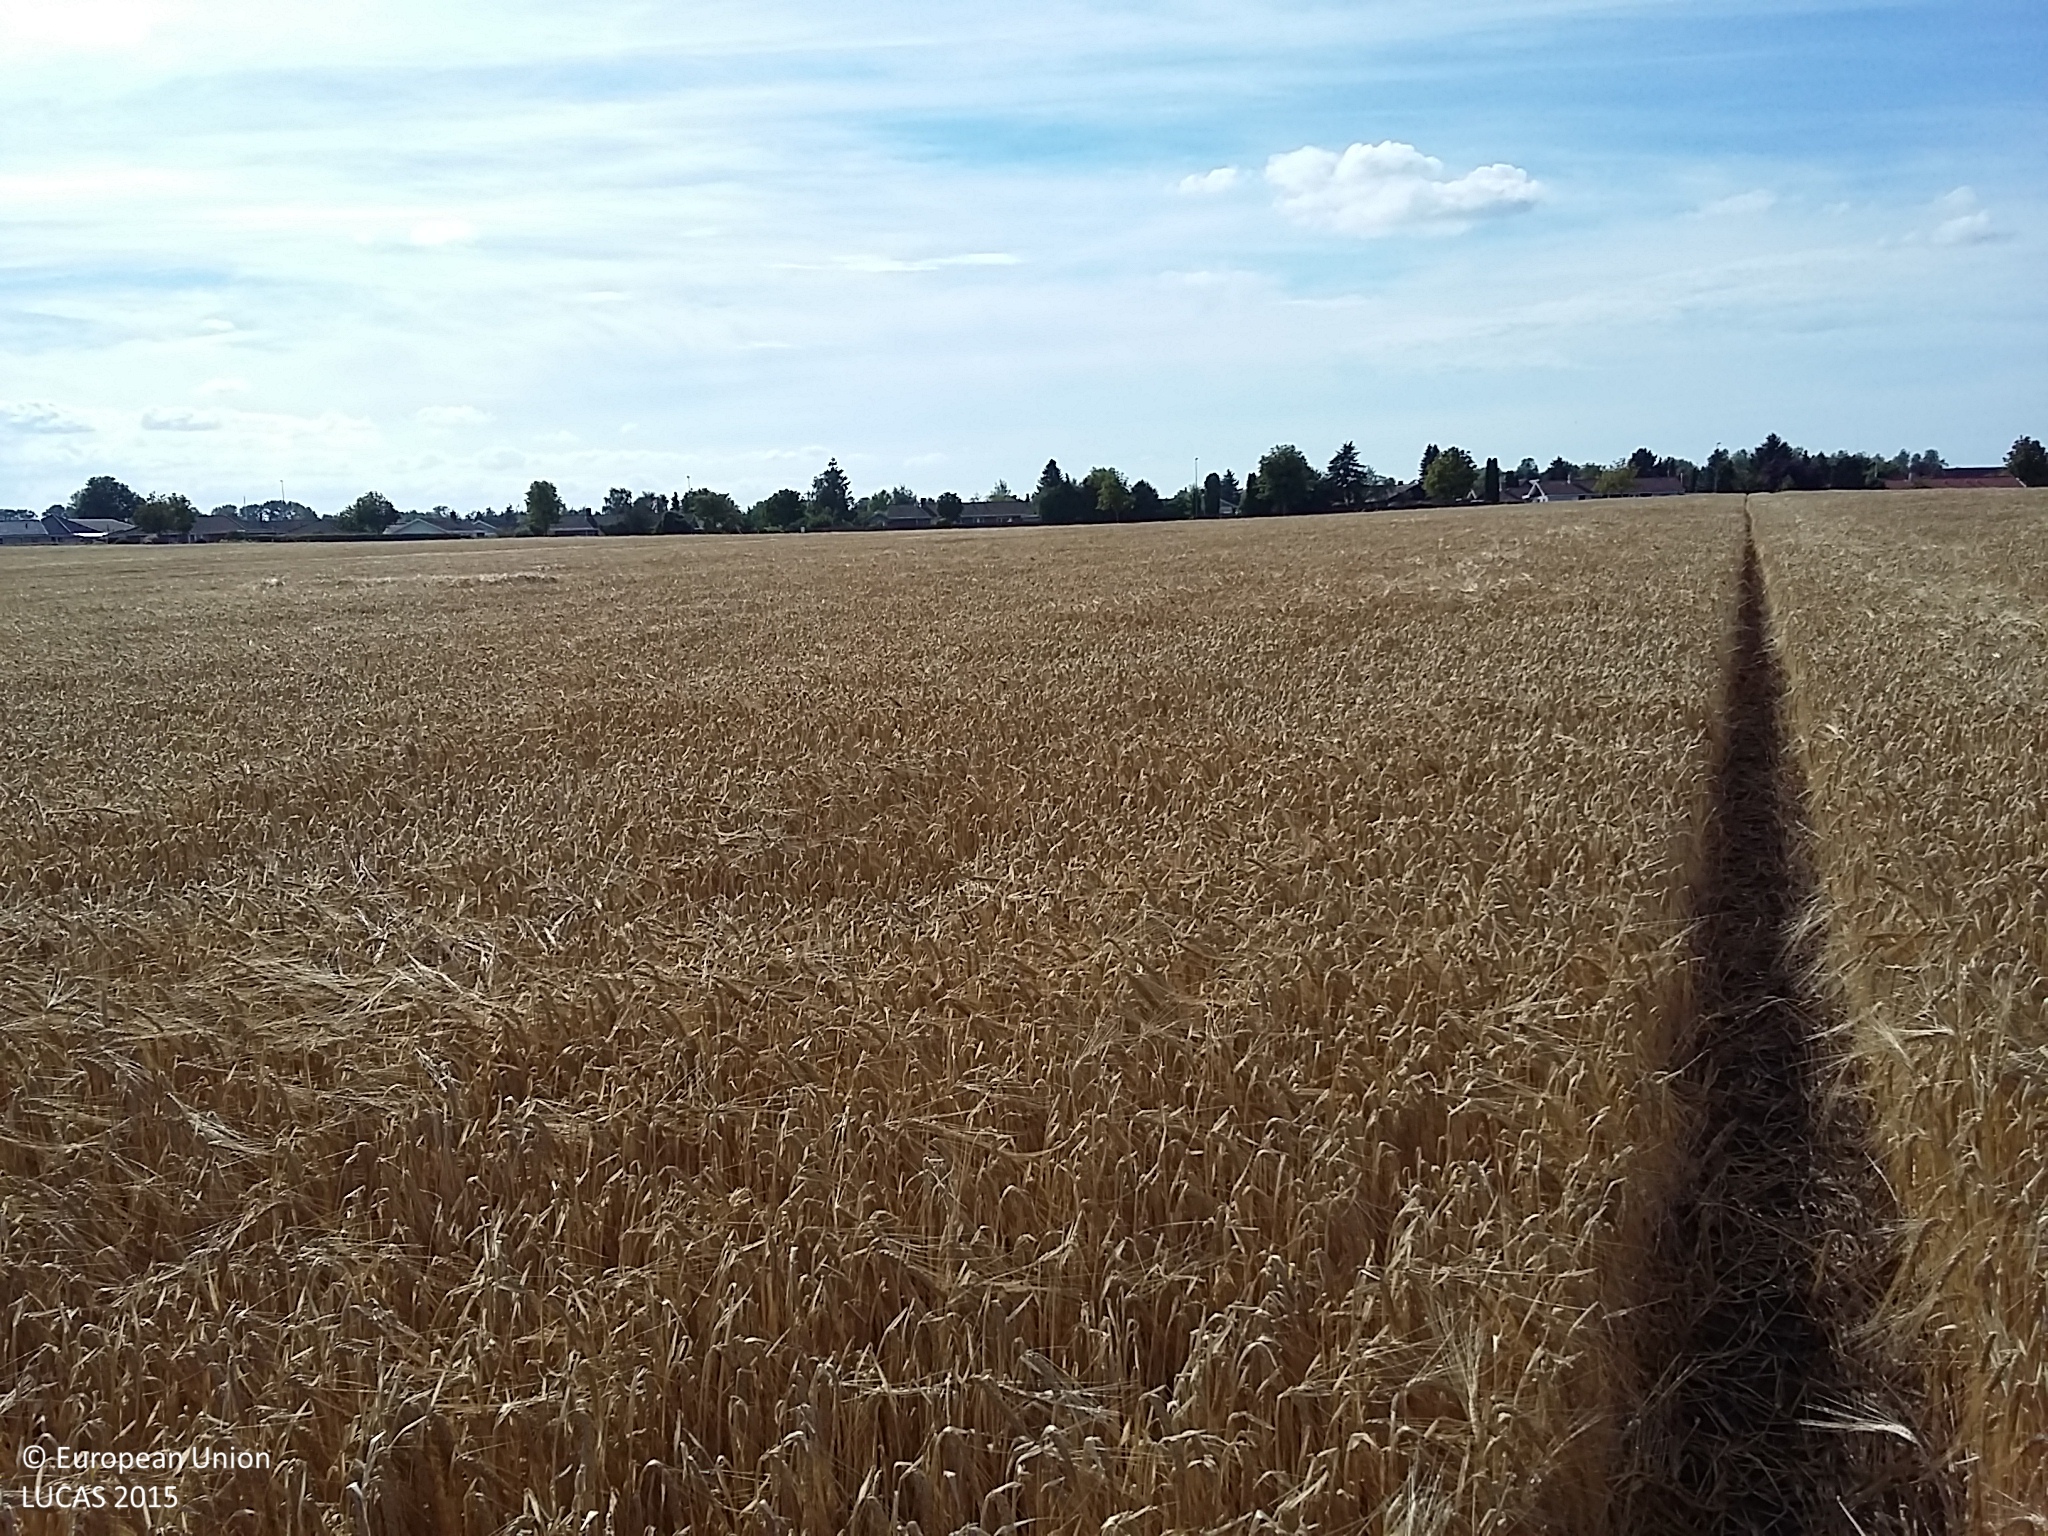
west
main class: Cropland
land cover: Barley
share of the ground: > 75 %
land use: Agriculture (excluding fallow land and kitchen gardens)
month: August
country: DK
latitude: 55.5406
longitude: 12.1376
